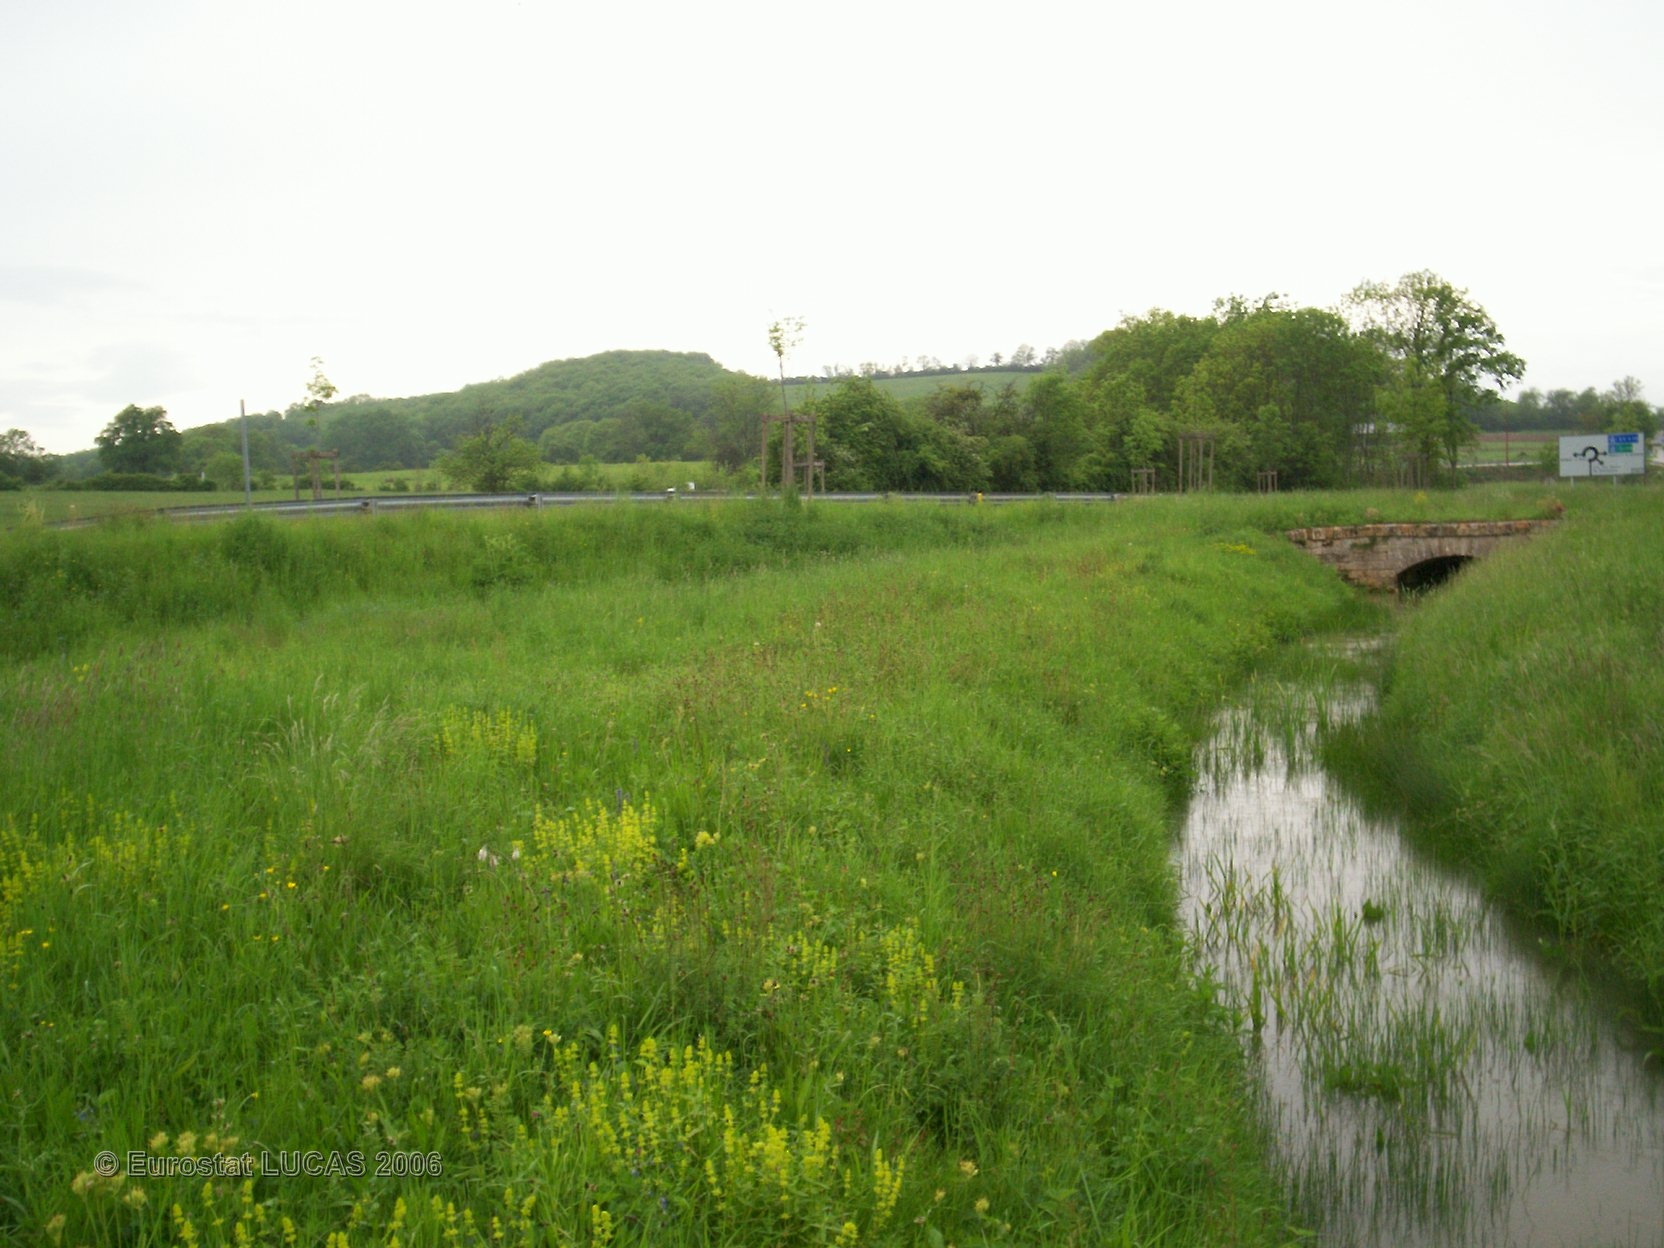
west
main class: Grassland
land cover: Grassland without tree/shrub cover
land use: Agriculture (excluding fallow land and kitchen gardens)
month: May
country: FR
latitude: 47.2420
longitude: 4.5702
